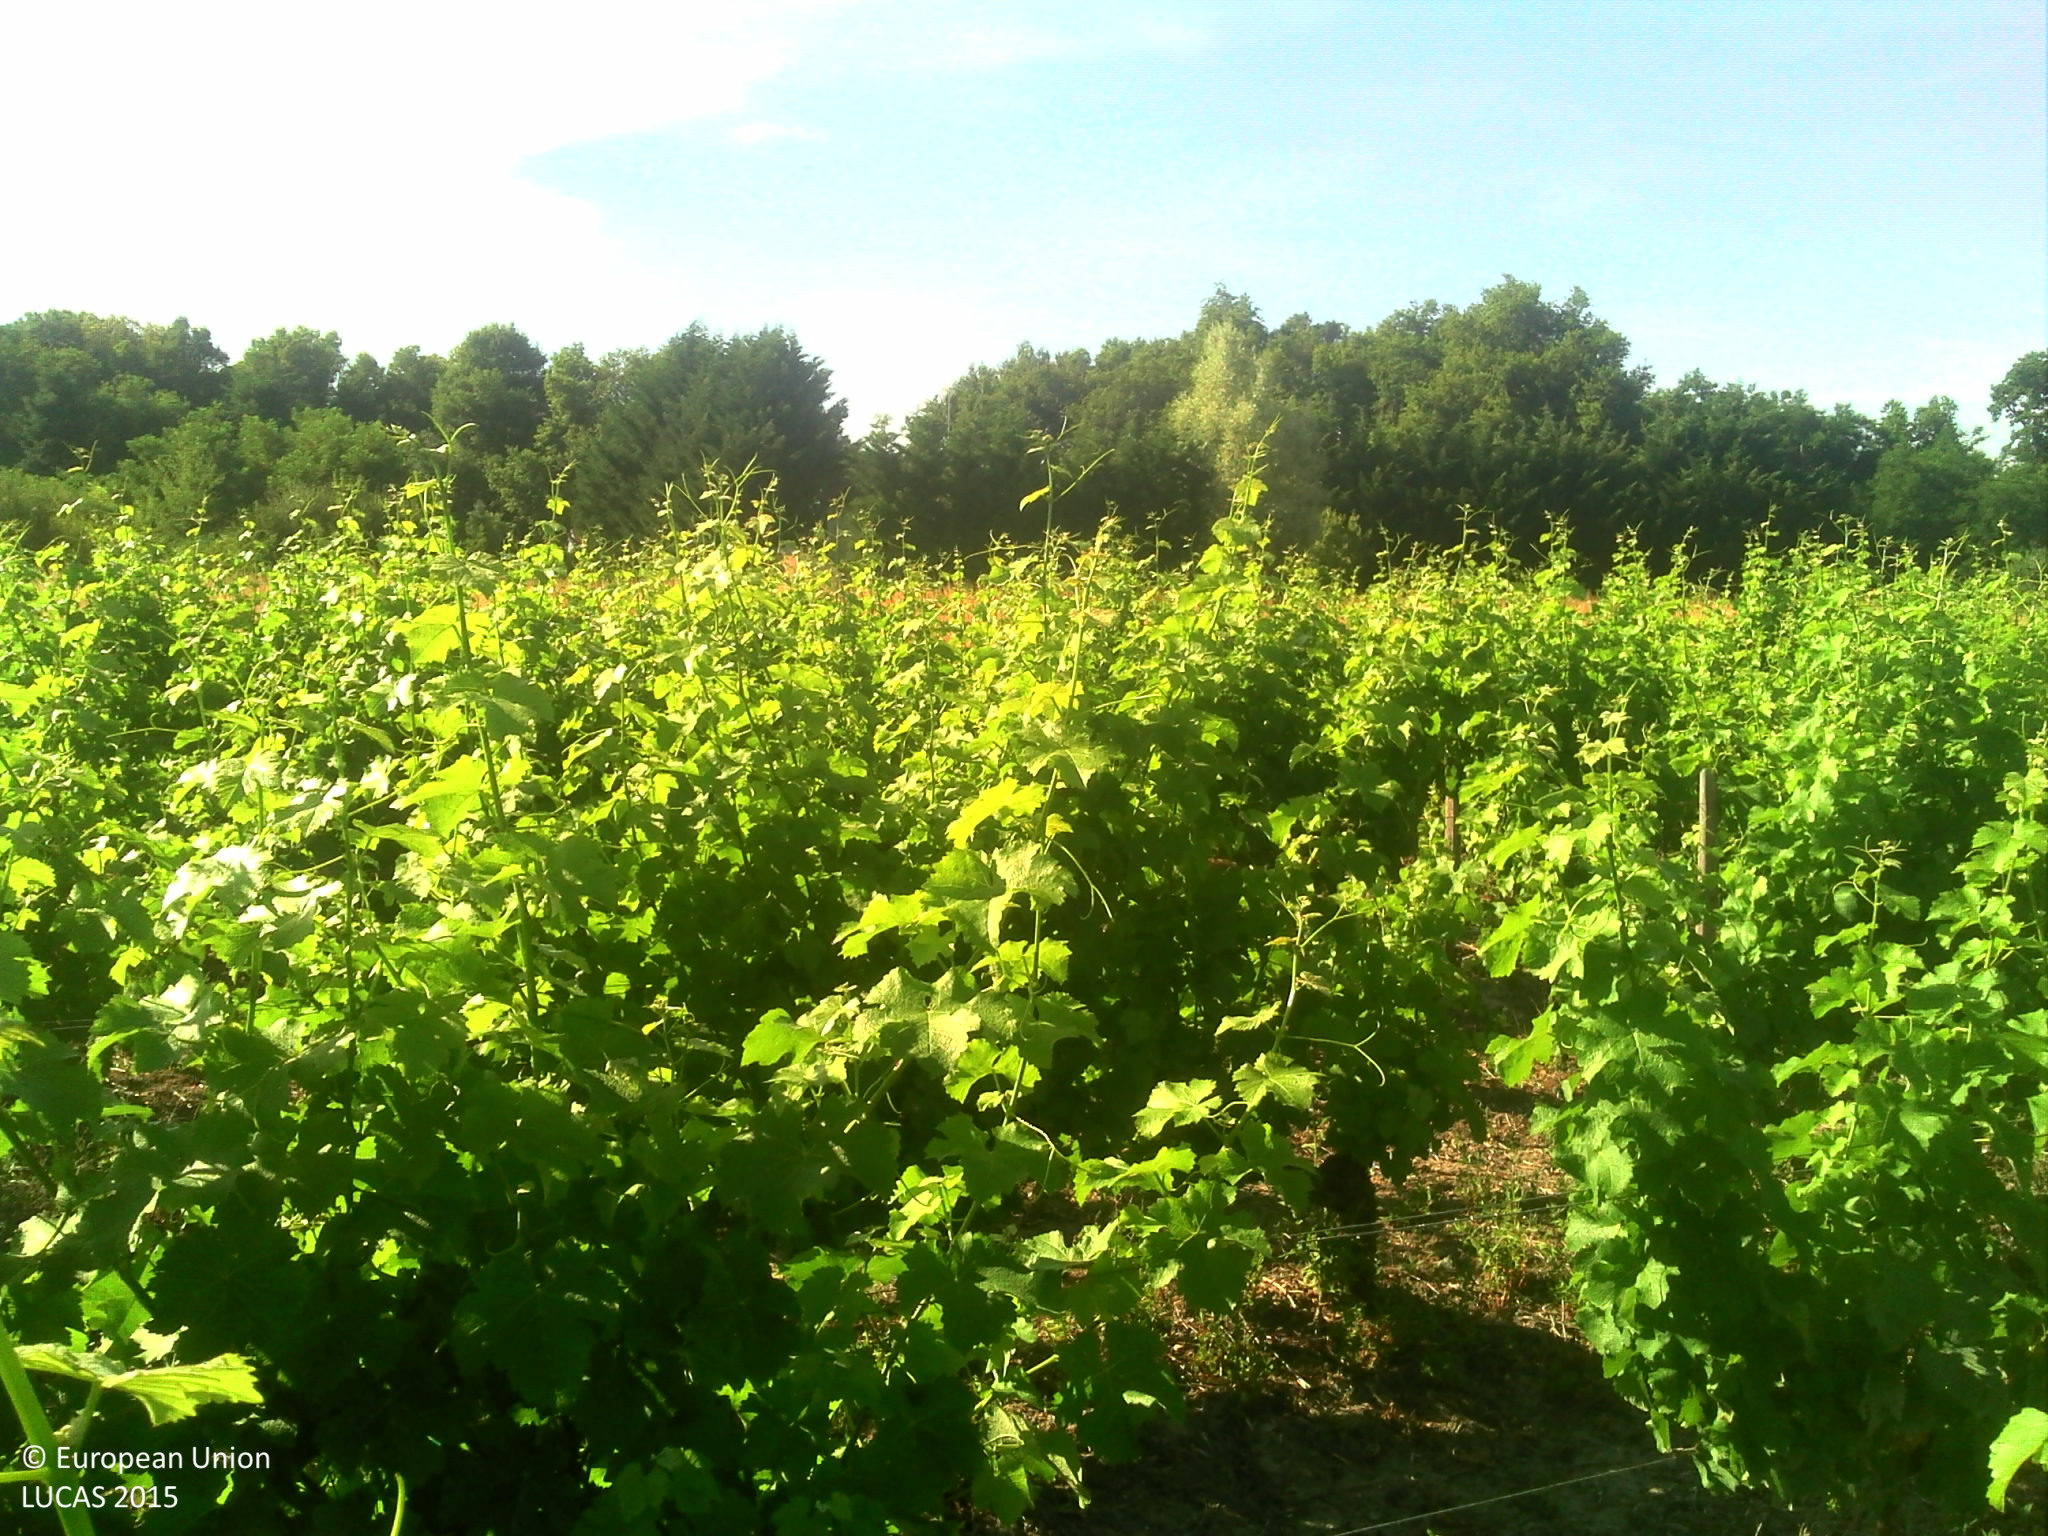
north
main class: Cropland
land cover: Vineyards
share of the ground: 25 - 50 %
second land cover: Other bare soil
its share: > 75 %
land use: Agriculture (excluding fallow land and kitchen gardens)
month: June
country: FR
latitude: 47.2764
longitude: 1.4602
